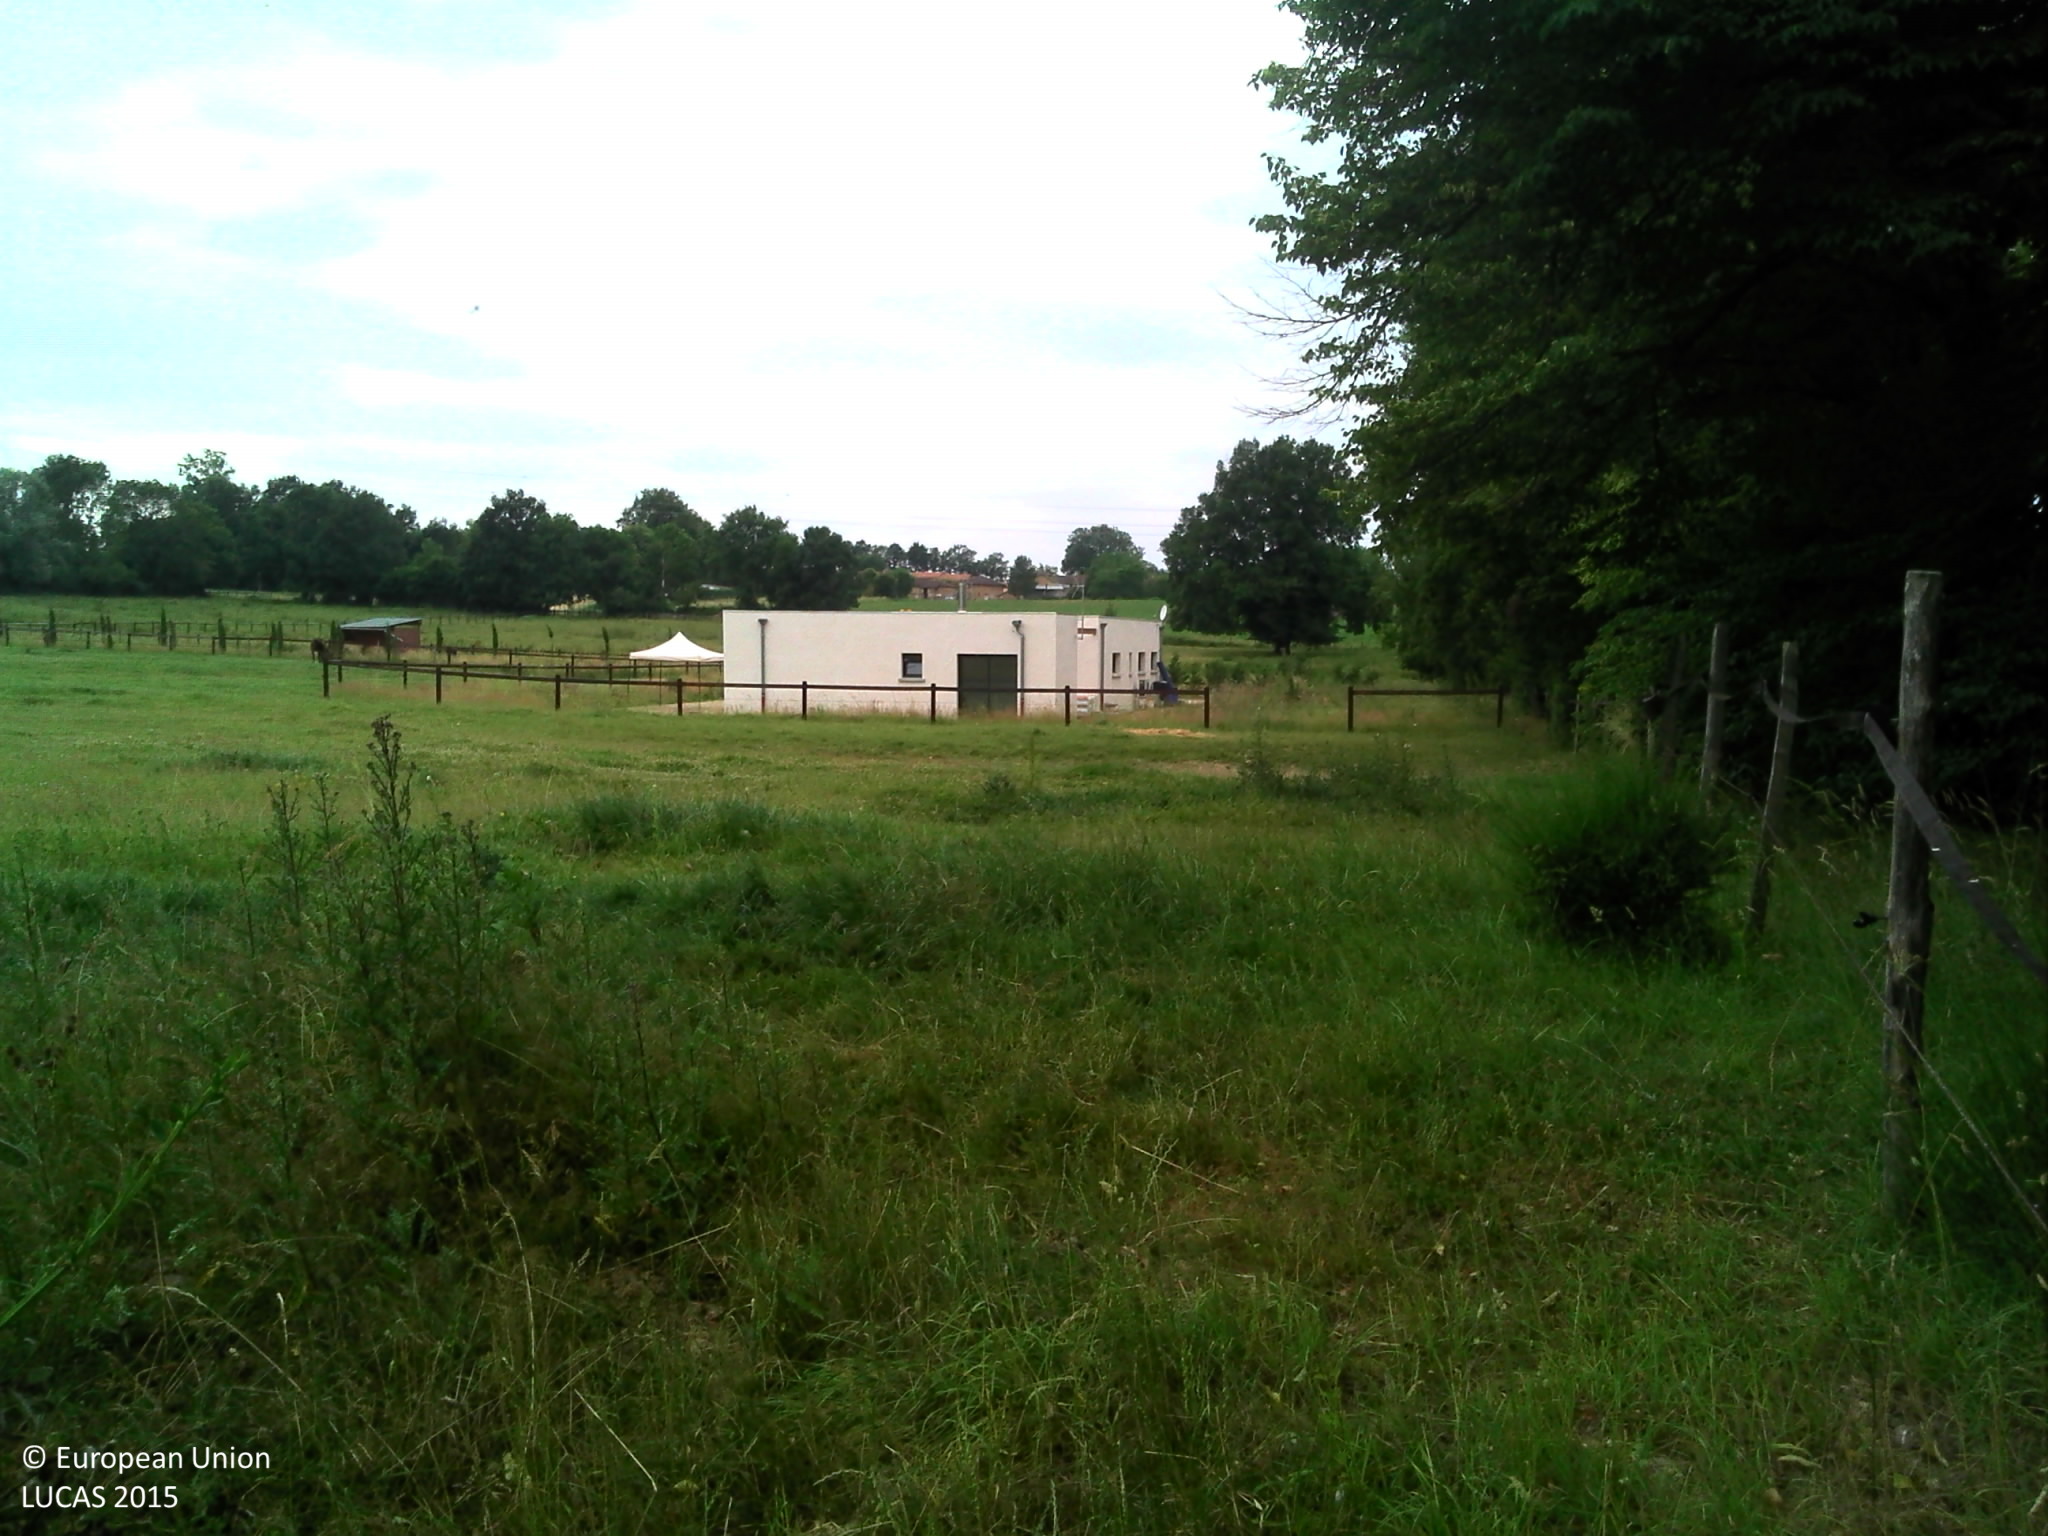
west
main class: Cropland
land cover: Rape and turnip rape
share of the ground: > 75 %
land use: Agriculture (excluding fallow land and kitchen gardens)
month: June
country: FR
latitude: 46.1221
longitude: 4.9170
